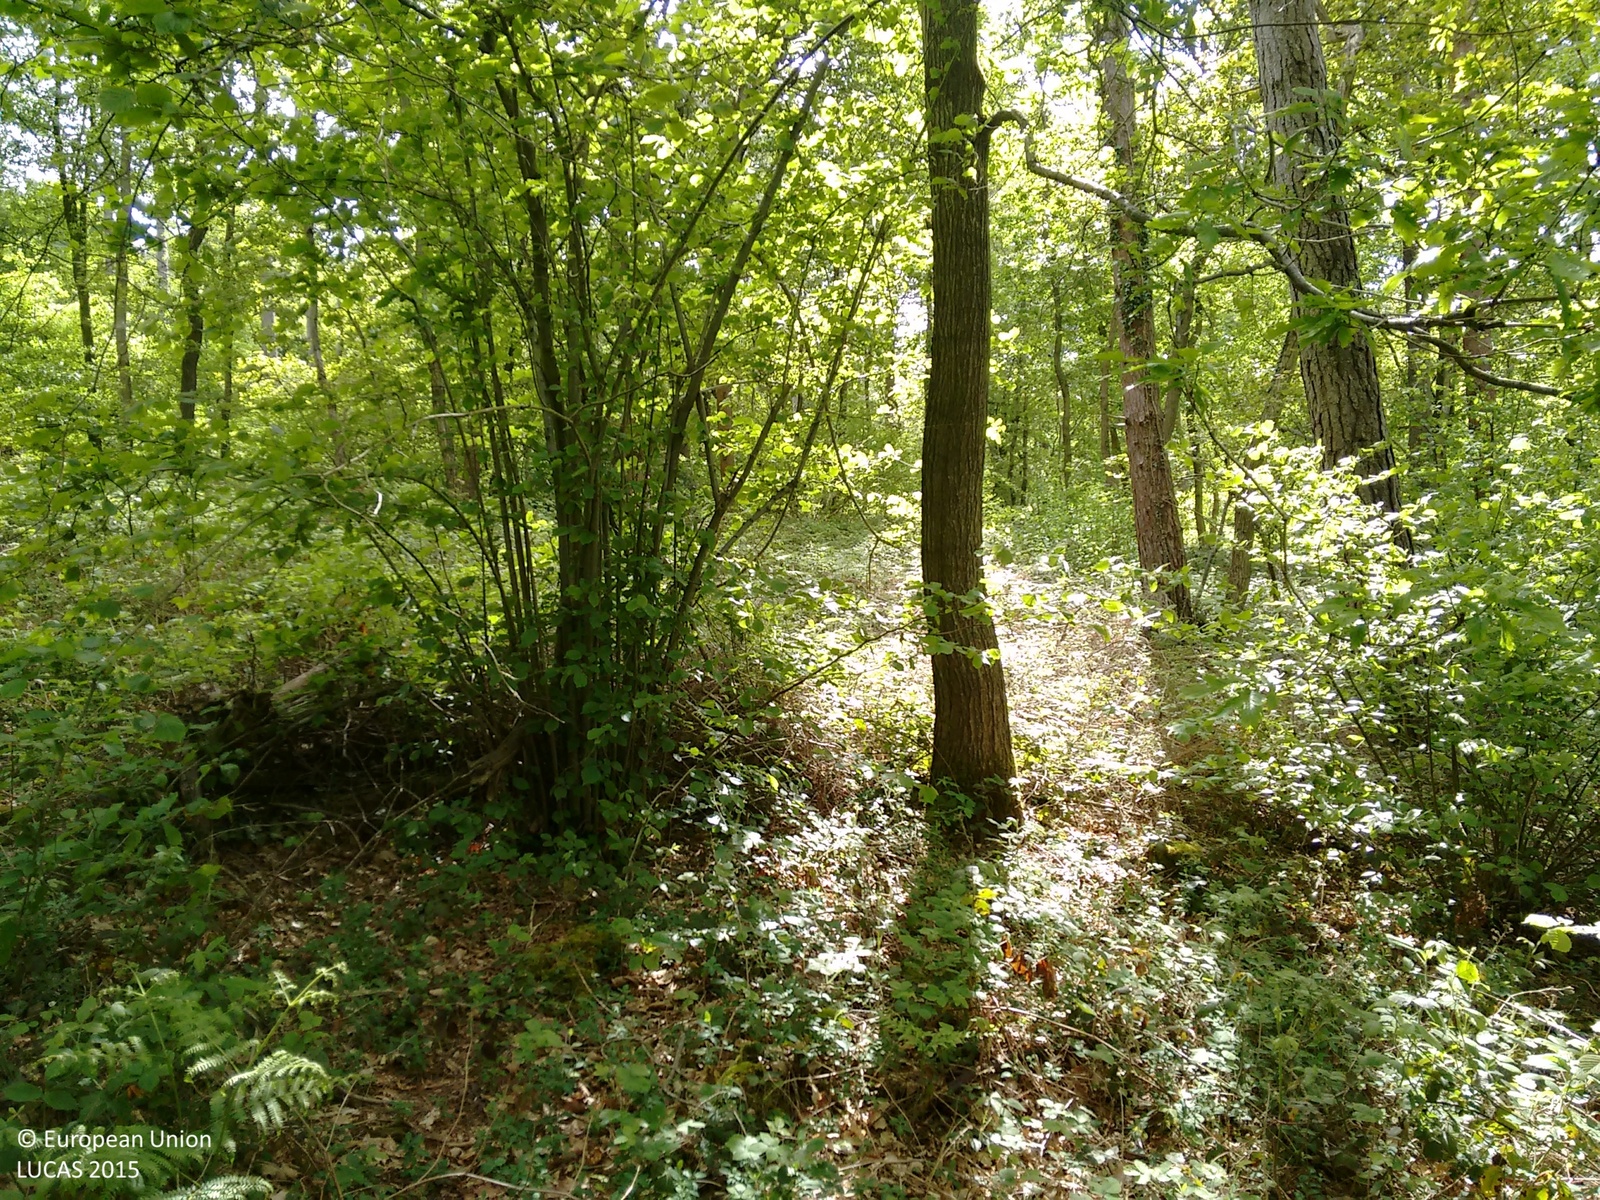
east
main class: Woodland
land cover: Other mixed woodland
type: hemiboreal forest and nemoral coniferous forest and mixed broadleaved-coniferous forest
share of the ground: > 75 %
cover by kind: coniferous forest trees 50 %, broadleaved forest trees 50 %
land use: Forestry
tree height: > 5 m
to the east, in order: Other mixed woodland; Tracks; Other mixed woodland; Broadleaved woodland
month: May
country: GB
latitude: 50.7244
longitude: -1.3388
